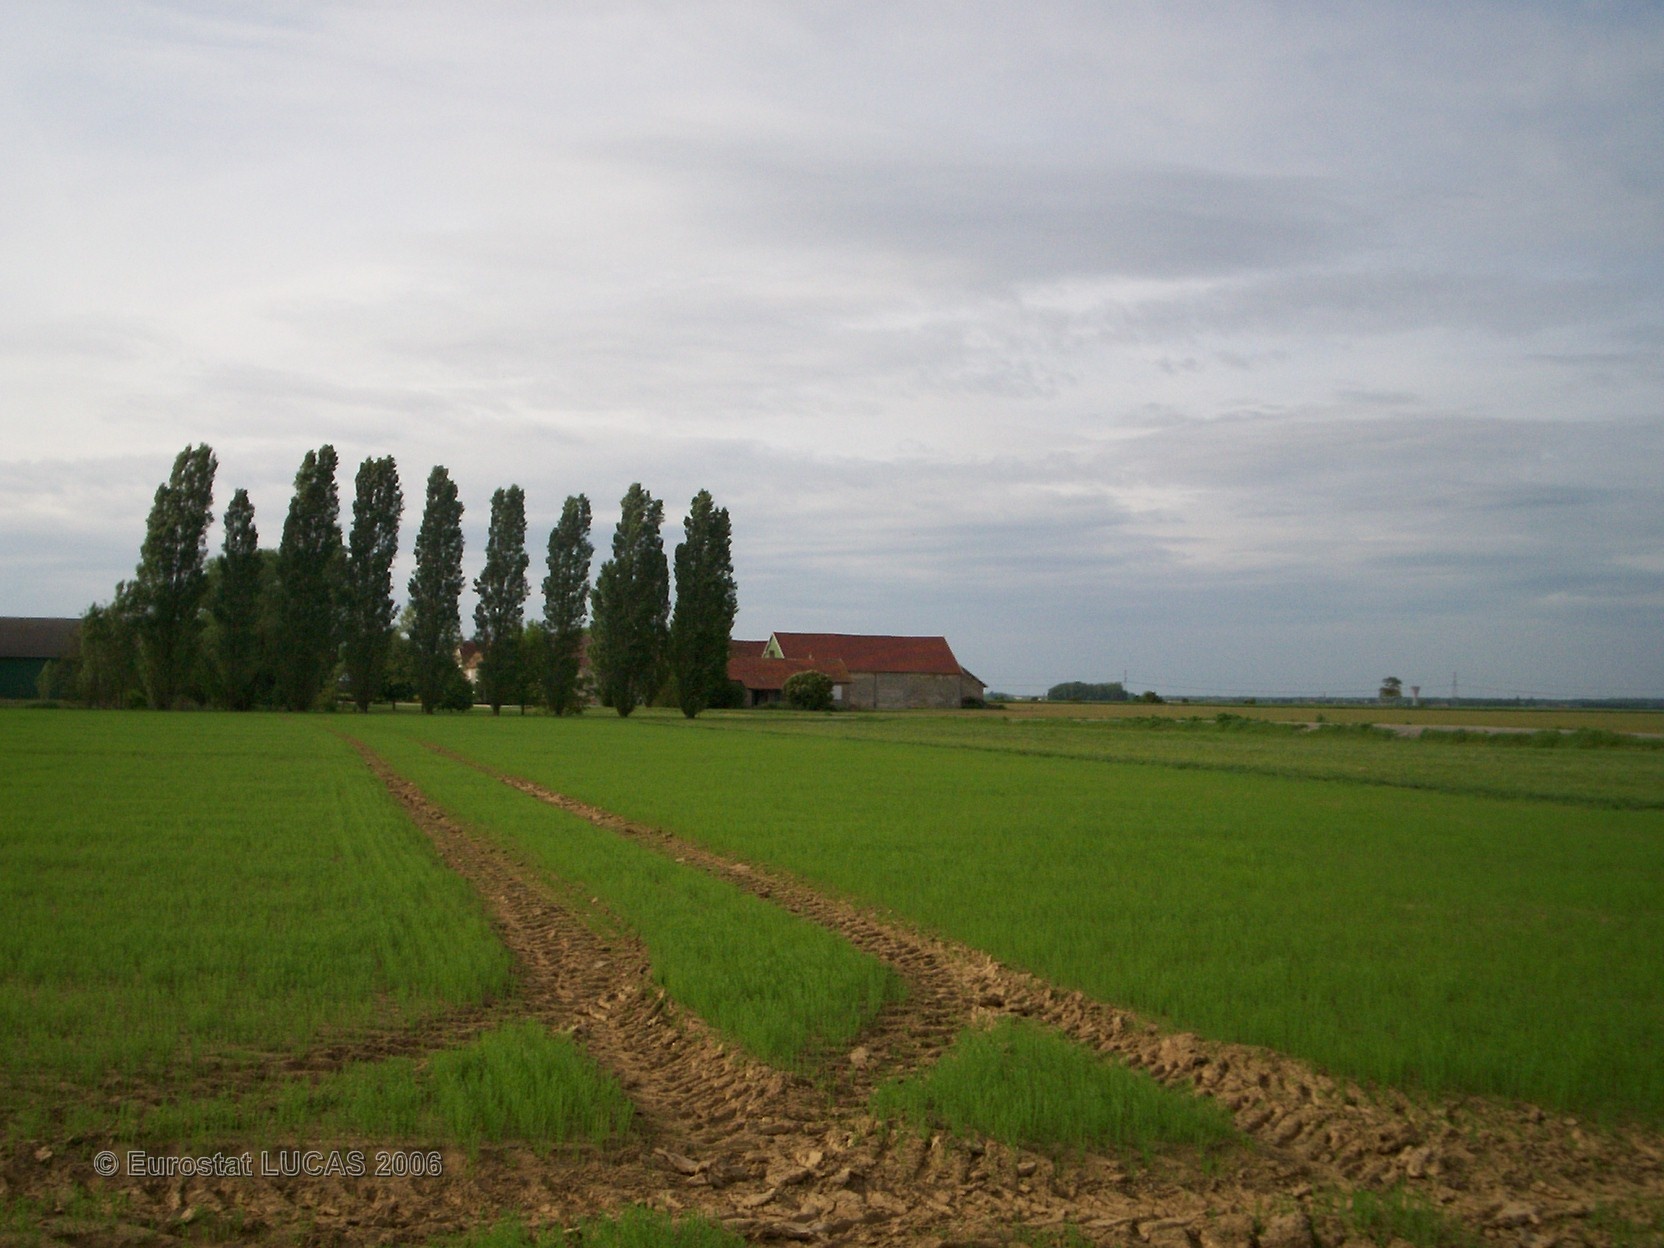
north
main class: Cropland
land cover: Other fibre and oleaginous crops
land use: Agriculture (excluding fallow land and kitchen gardens)
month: May
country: FR
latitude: 48.6015
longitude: 2.7899
